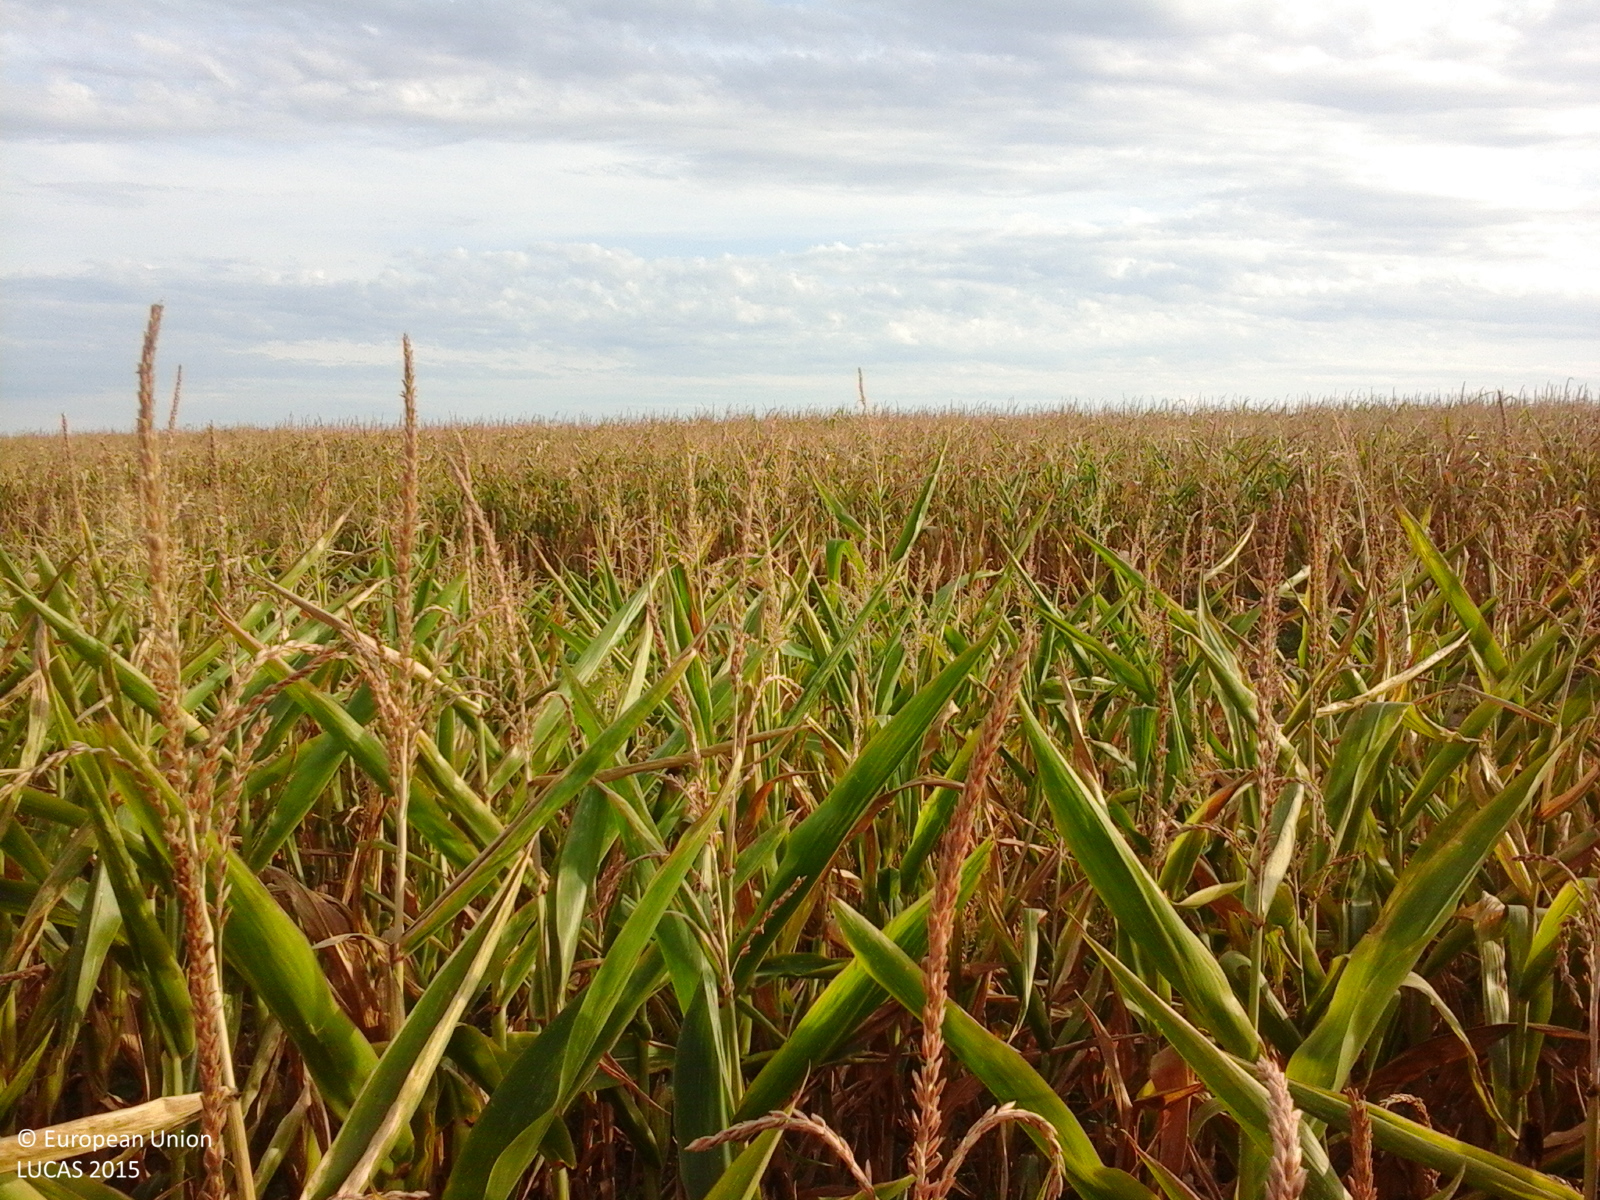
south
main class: Cropland
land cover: Maize
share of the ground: > 75 %
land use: Agriculture (excluding fallow land and kitchen gardens)
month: August
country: RO
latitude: 45.0478
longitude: 21.5714
